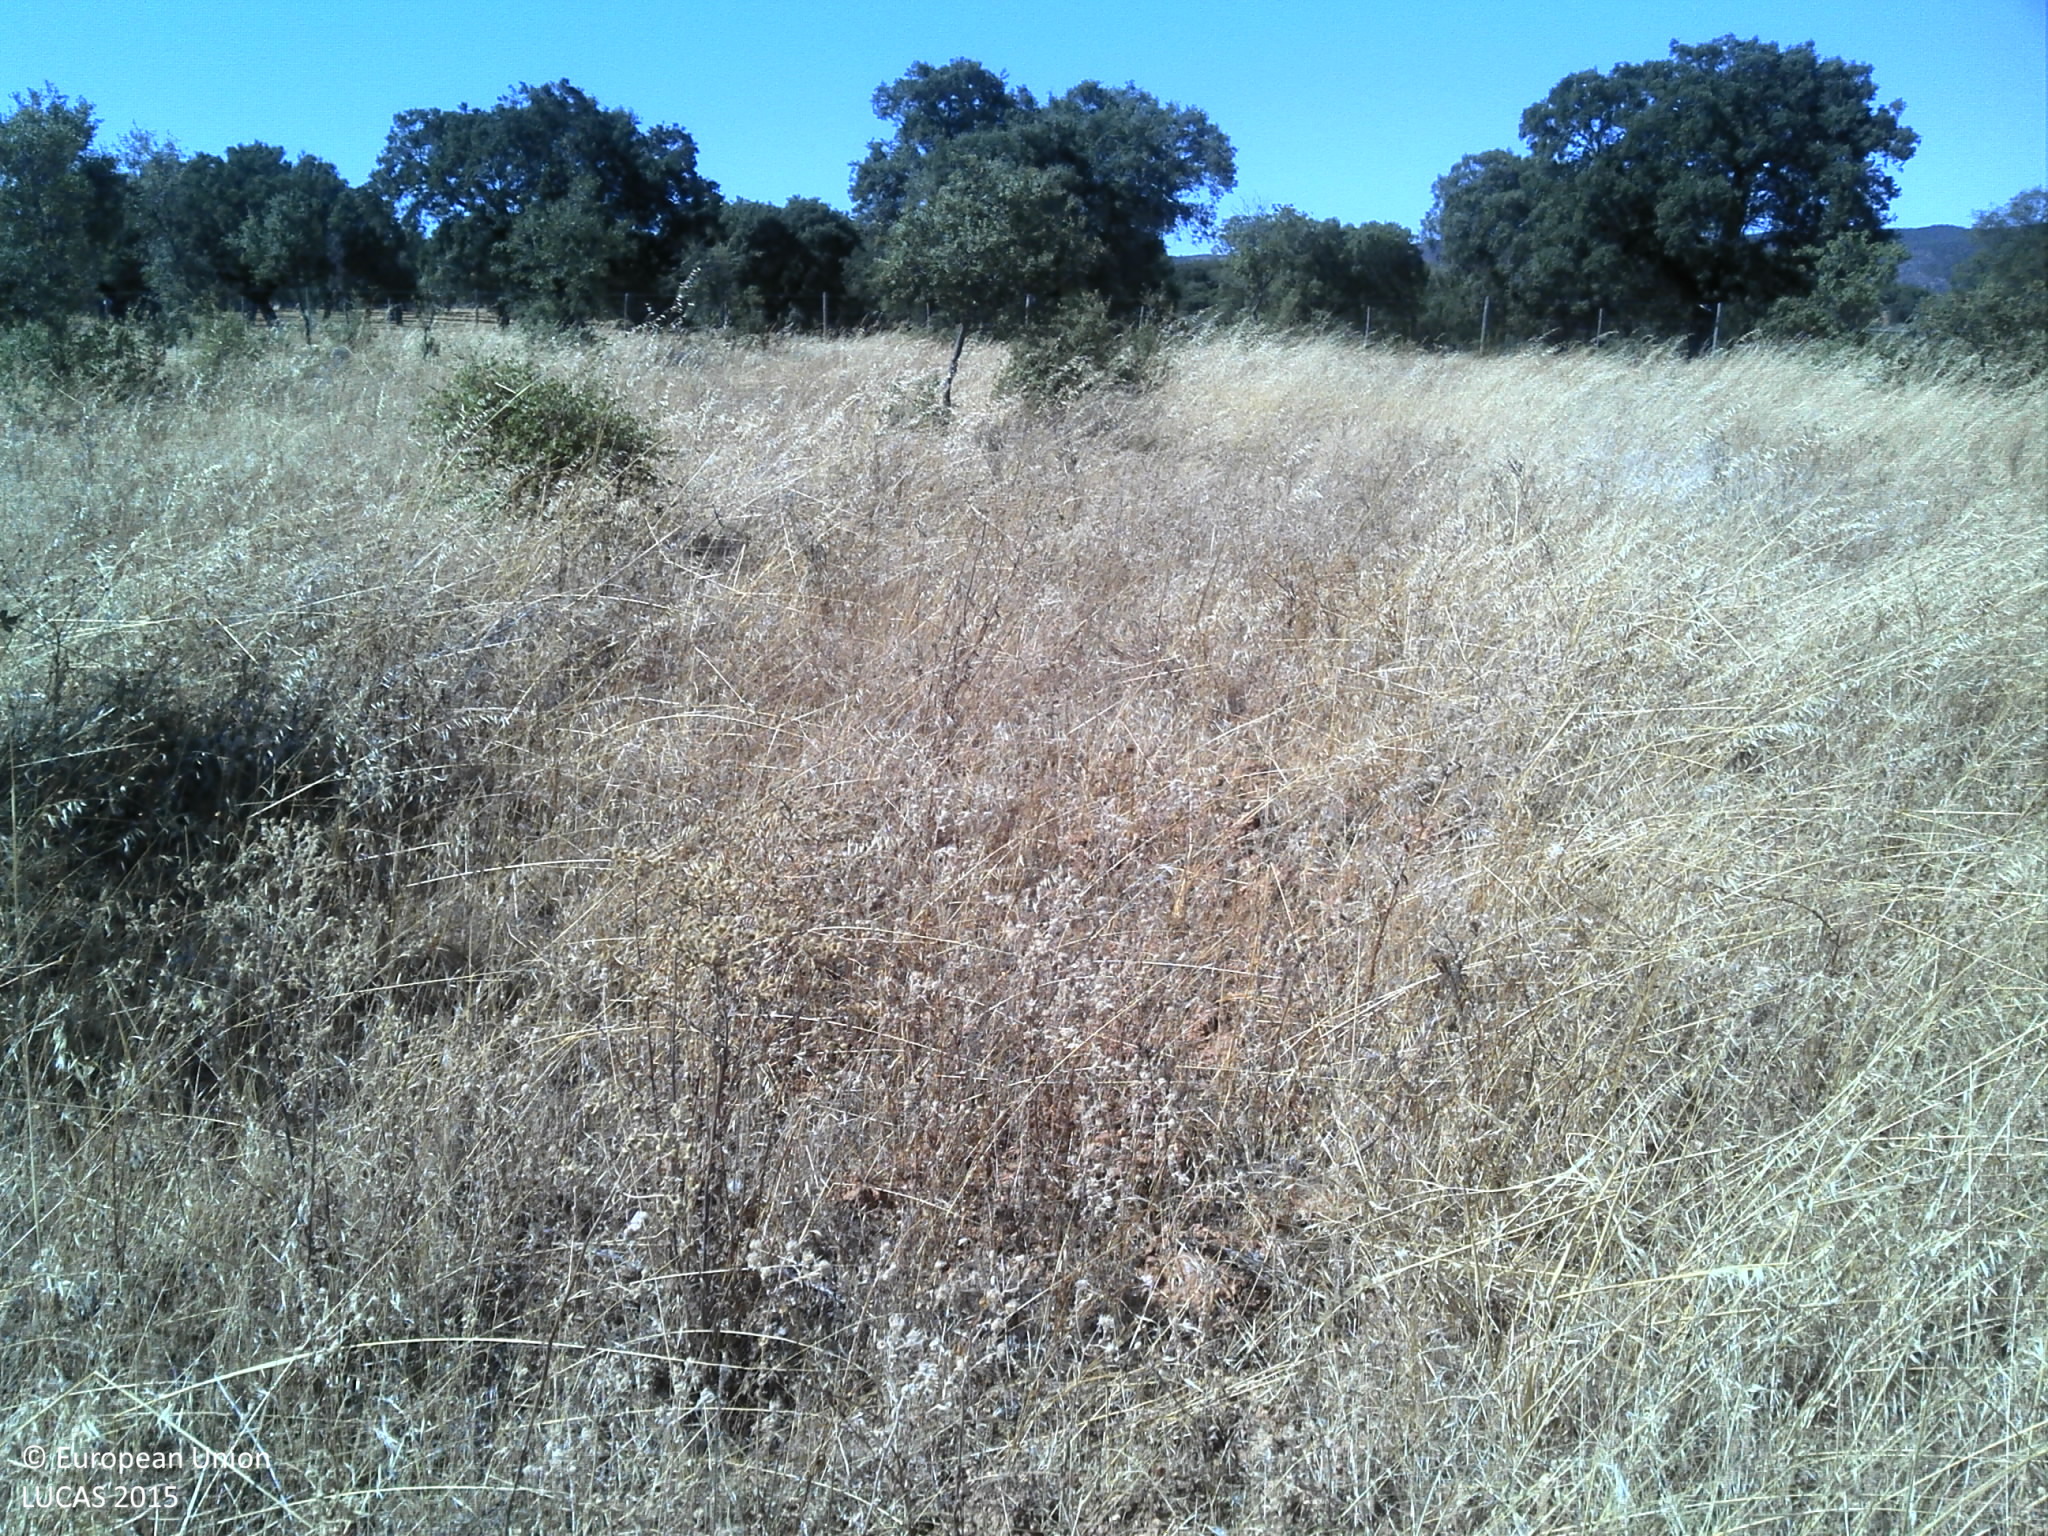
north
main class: Woodland
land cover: Broadleaved woodland
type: broadleaved evergreen forest
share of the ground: 25 - 50 %
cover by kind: broadleaved forest trees 40 %, unconsolidated bare surface 30 %, herbaceous plants 25 %, shrubs 5 %
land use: Forestry
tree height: < 5 m
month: July
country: PT
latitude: 38.1753
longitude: -7.7328
